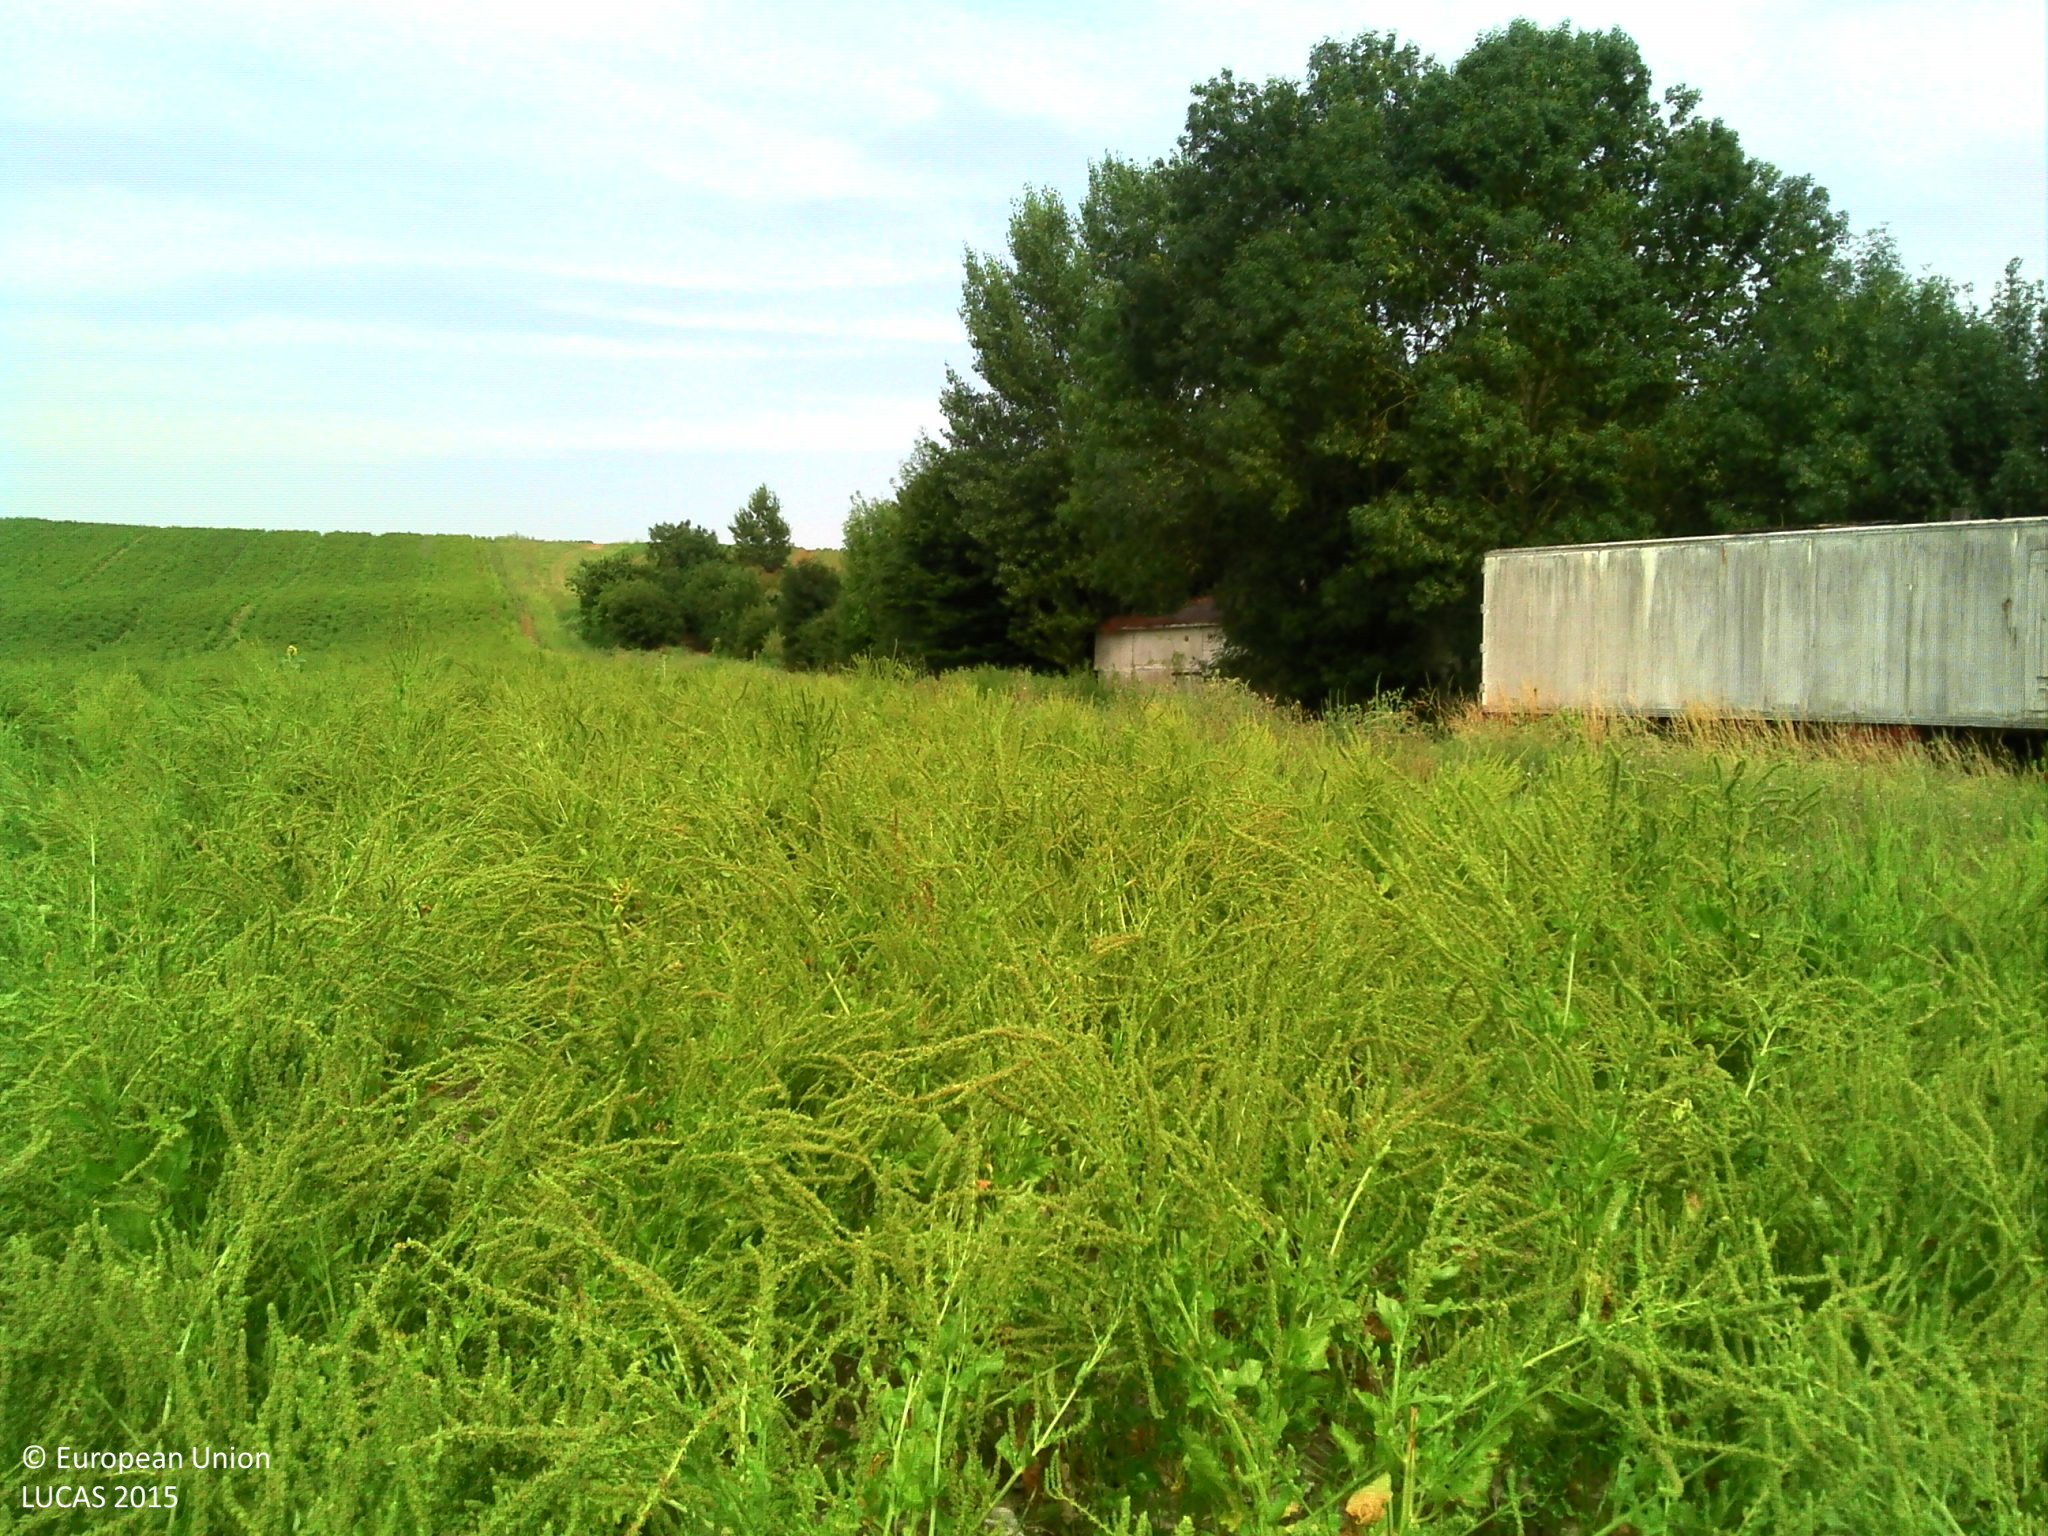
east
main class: Cropland
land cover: Sugar beet
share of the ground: > 75 %
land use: Agriculture (excluding fallow land and kitchen gardens)
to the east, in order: Sugar beet; Spontaneously vegetated surfaces; Fences; Broadleaved woodland; Grassland without tree/shrub cover; Artificial constructions in urban areas; Single bushes/trees; Tracks; Grass margins; Fences; Broadleaved woodland; Spontaneously vegetated surfaces; Maize
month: July
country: FR
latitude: 44.4744
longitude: 0.8805
